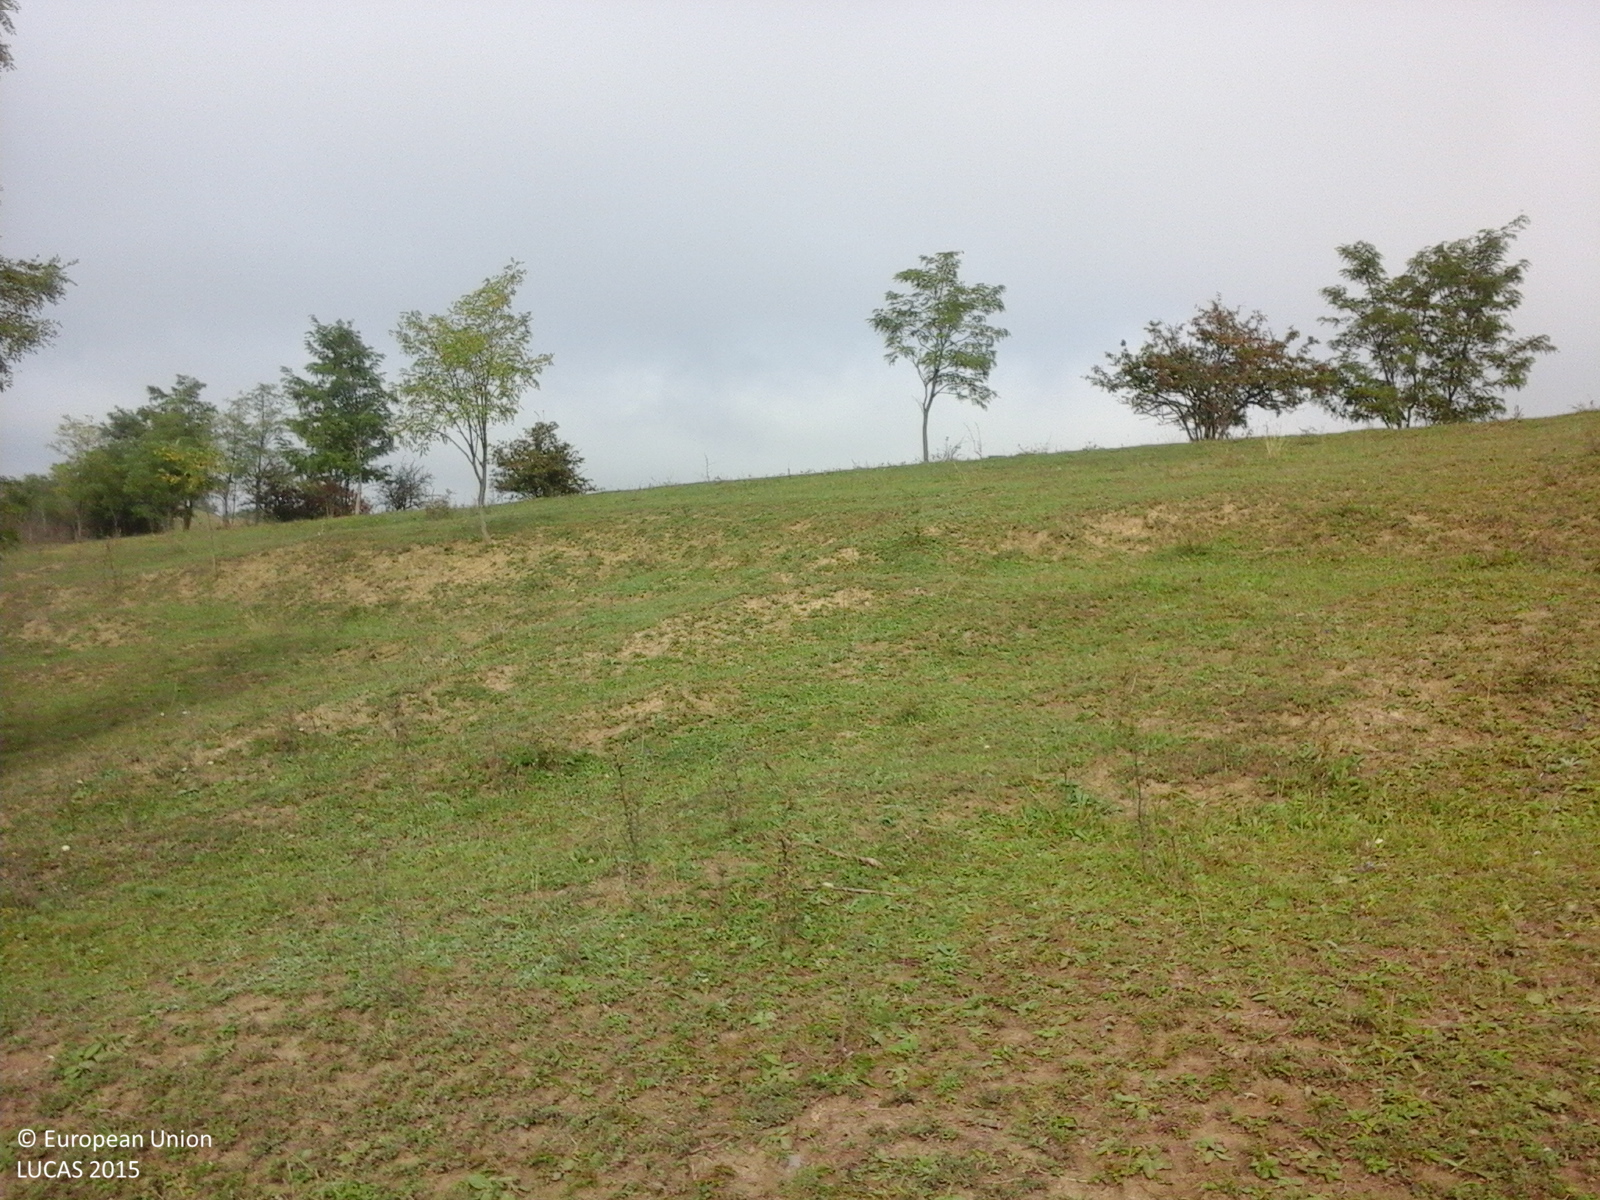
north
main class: Grassland
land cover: Grassland without tree/shrub cover
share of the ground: > 75 %
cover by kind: herbaceous plants 100 %
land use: Agriculture (excluding fallow land and kitchen gardens)
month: October
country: RO
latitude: 46.6371
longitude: 24.3629
